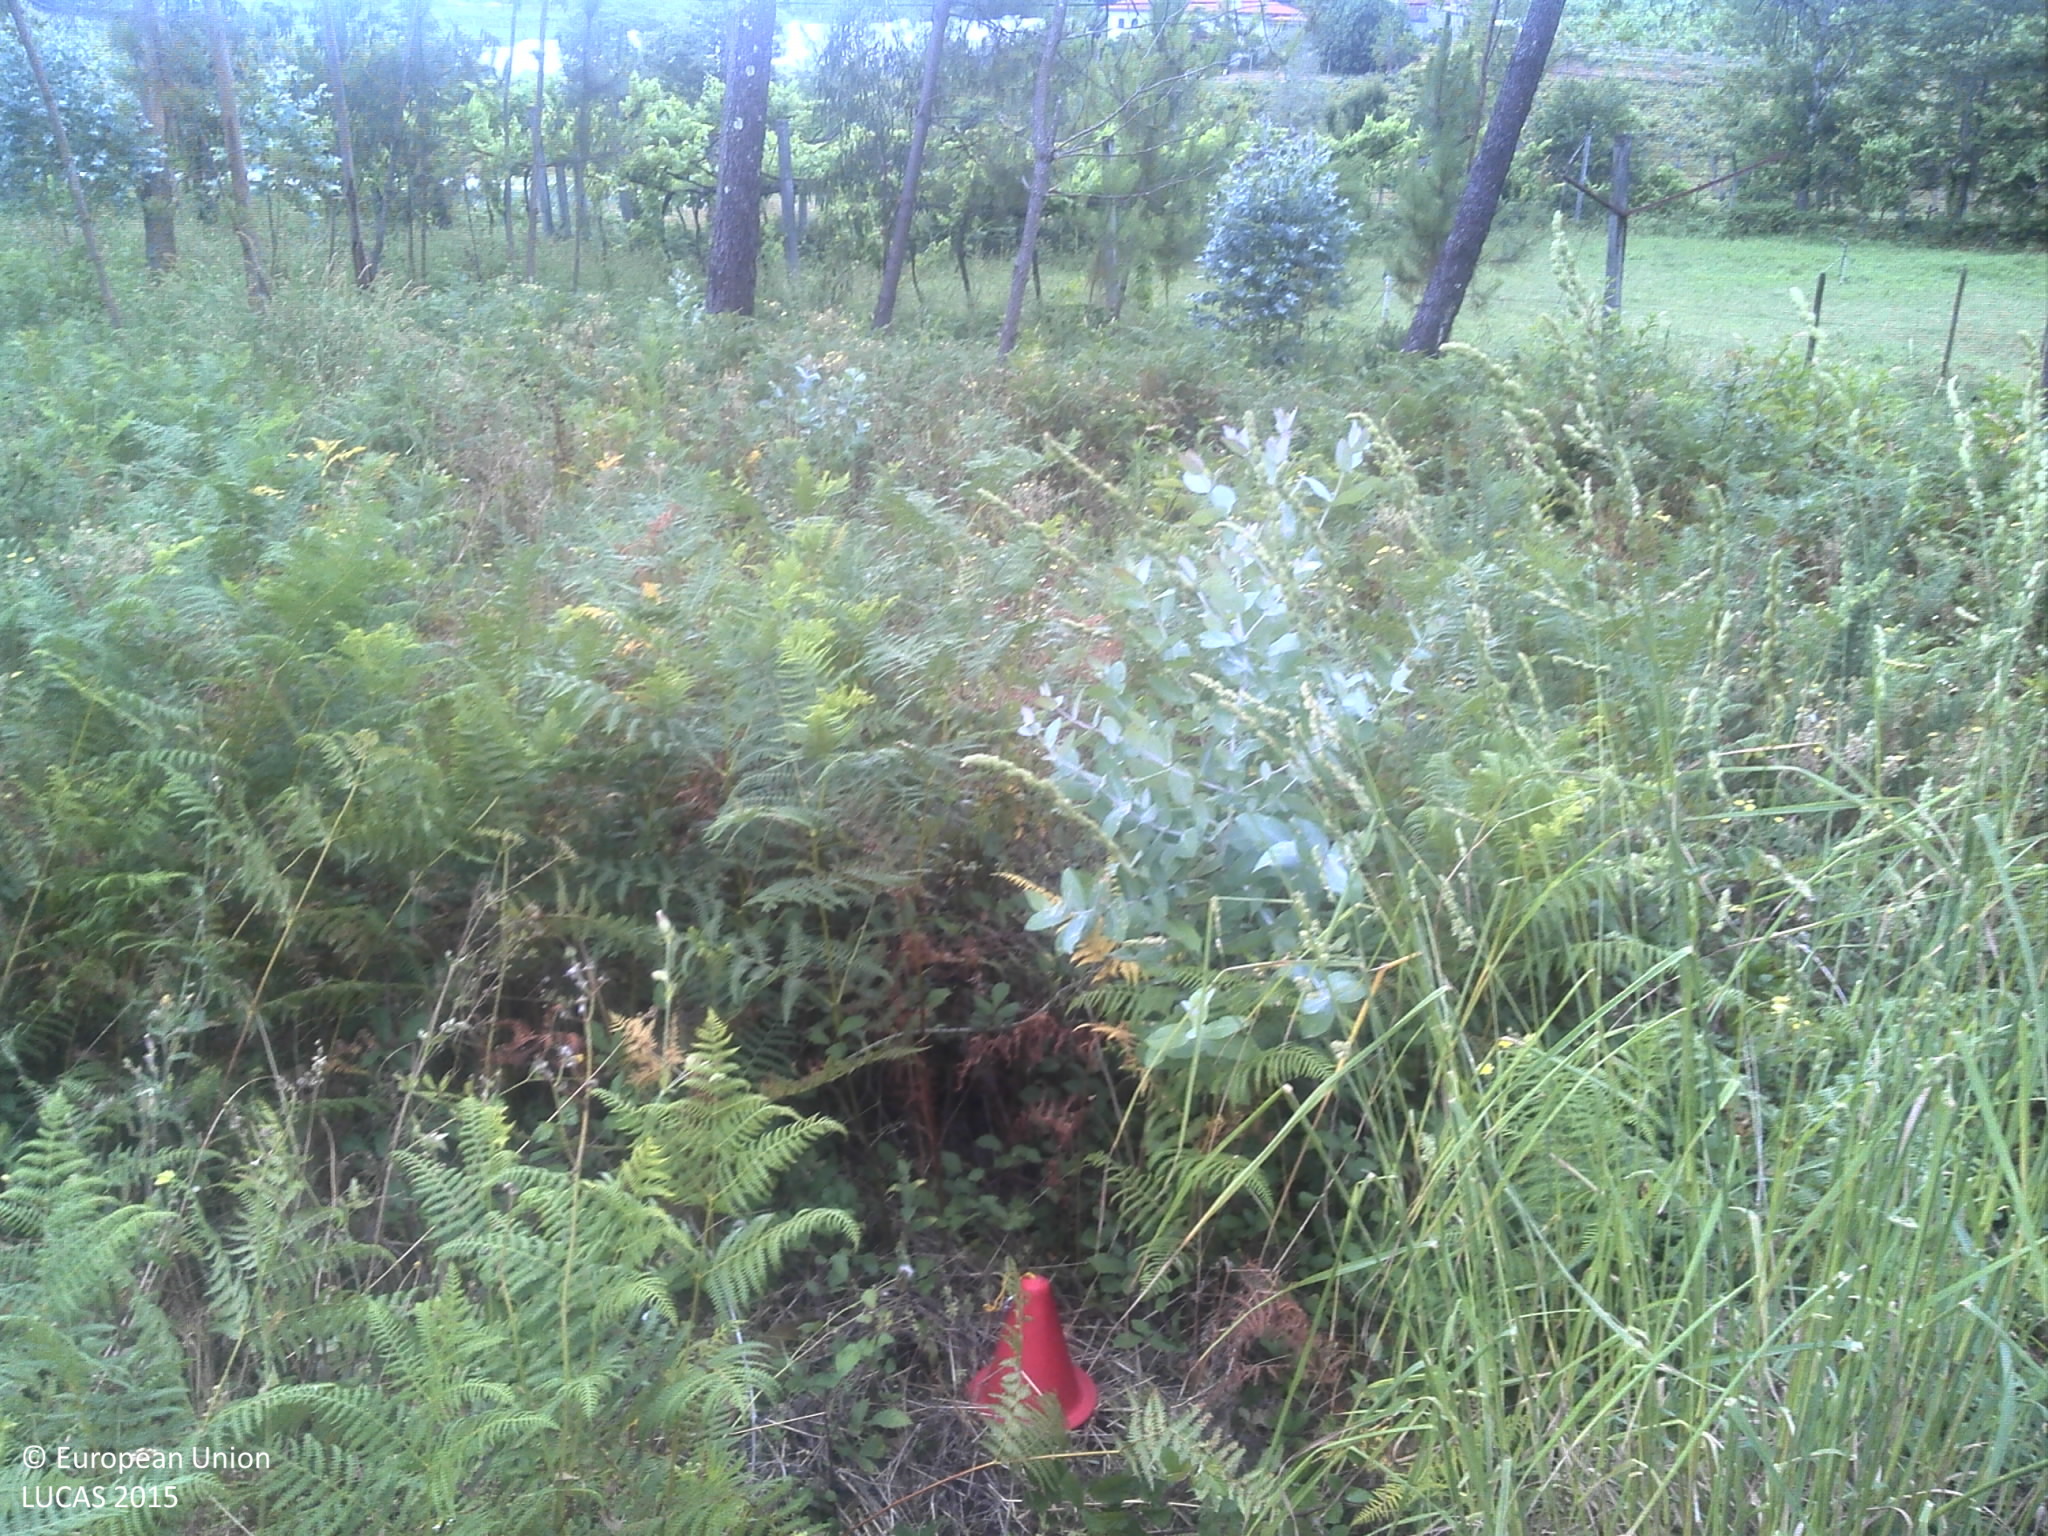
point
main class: Shrubland
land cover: Shrubland with sparse tree cover
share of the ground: 50 - 75 %
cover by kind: shrubs 90 %, broadleaved forest trees 5 %, unconsolidated bare surface 5 %
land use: Forestry
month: June
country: PT
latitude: 41.6367
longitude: -8.3894
